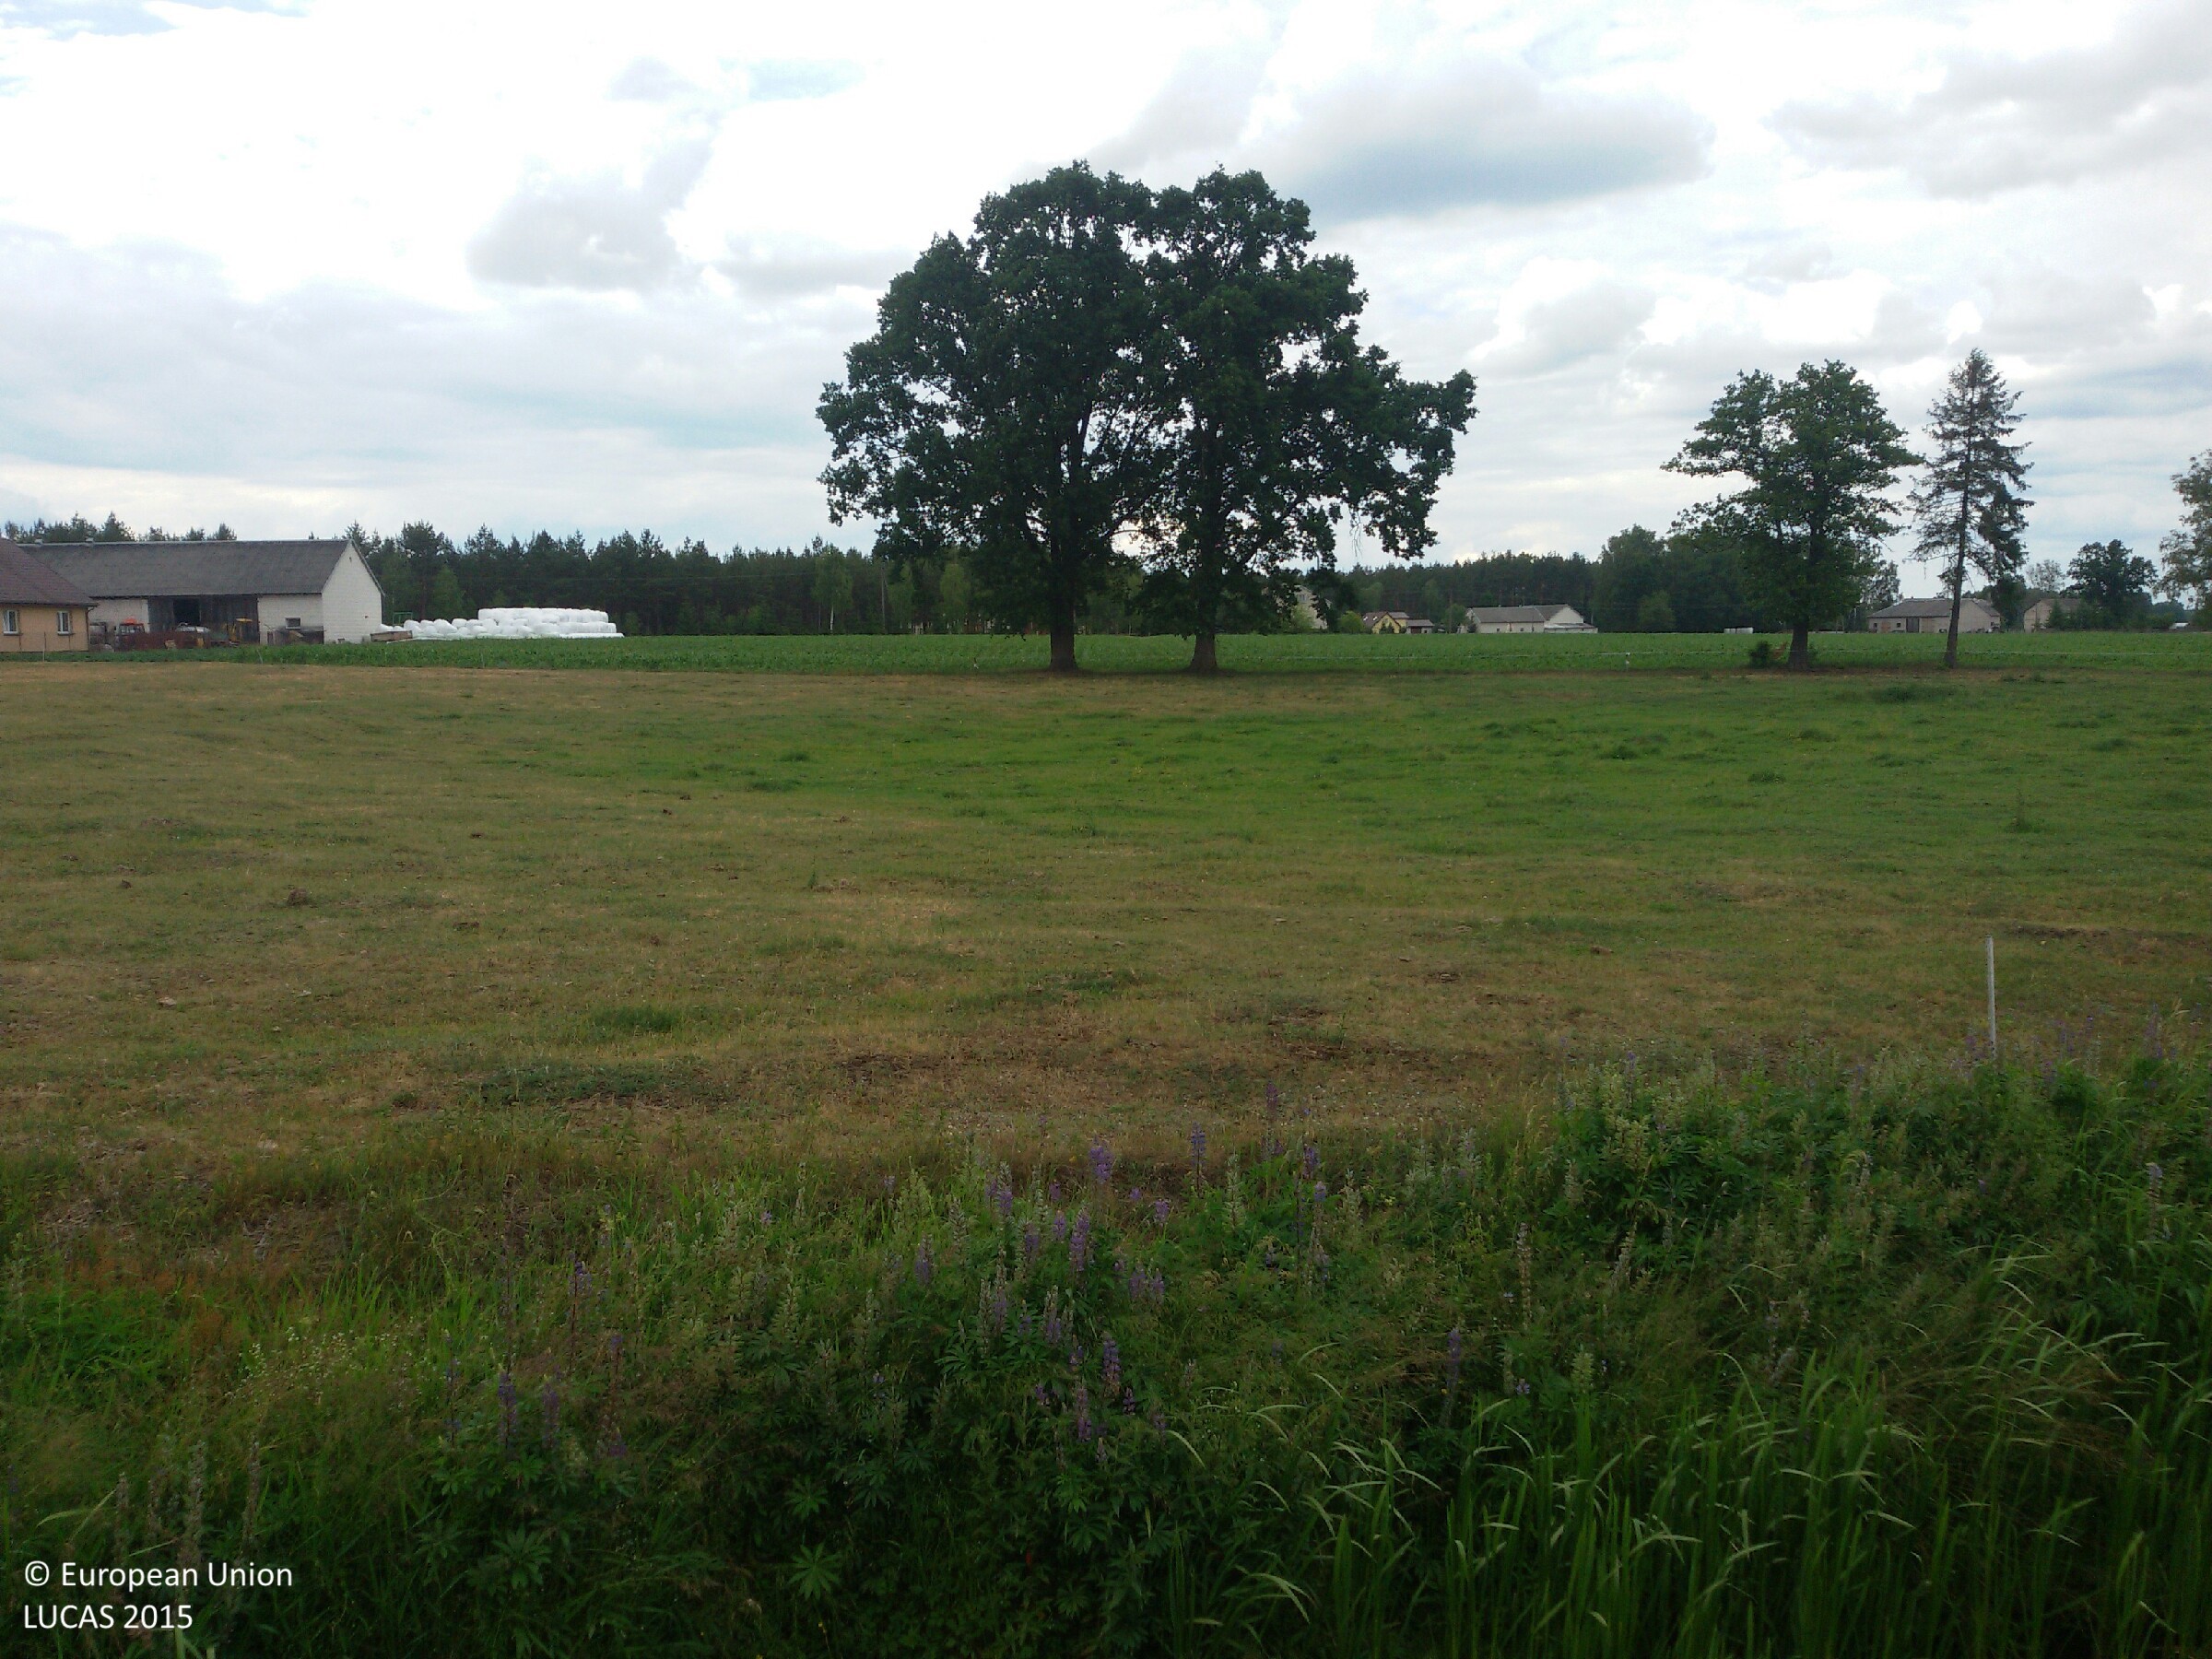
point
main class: Grassland
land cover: Grassland without tree/shrub cover
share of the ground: > 75 %
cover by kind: herbaceous plants 100 %
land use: Agriculture (excluding fallow land and kitchen gardens)
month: June
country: PL
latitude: 53.2824
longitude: 20.9774
